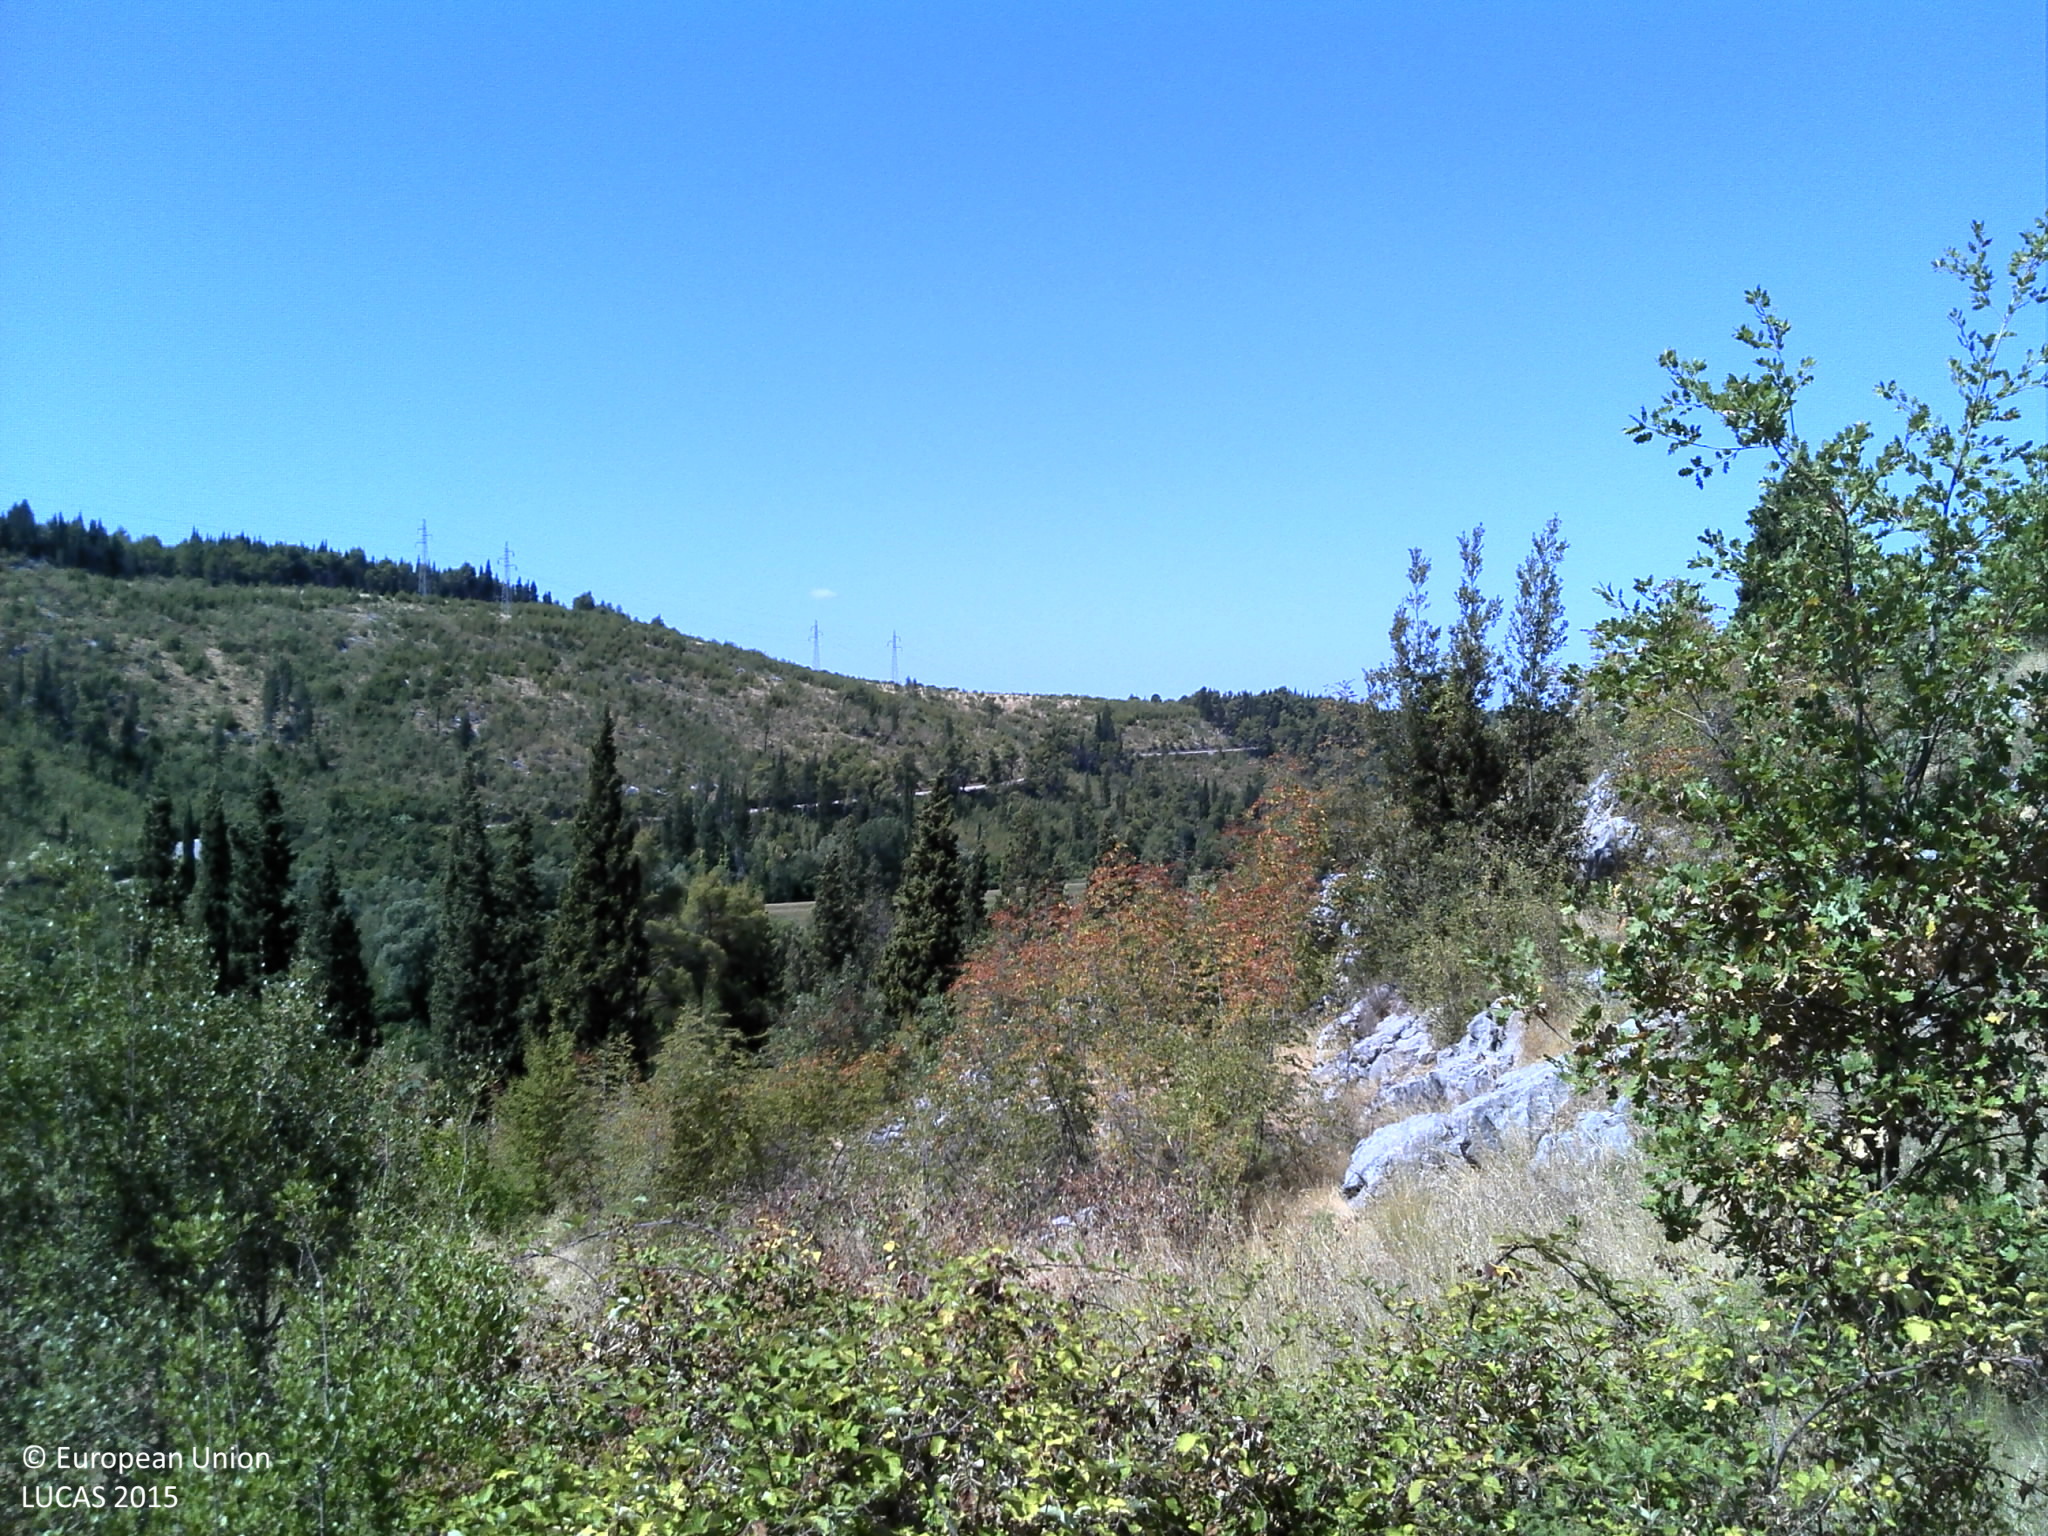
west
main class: Shrubland
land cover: Shrubland with sparse tree cover
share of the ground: > 75 %
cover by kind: shrubs 50 %, unconsolidated bare surface 30 %, herbaceous plants 15 %, coniferous forest trees 5 %
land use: Semi-natural and natural areas not in use
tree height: < 5 m
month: July
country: HR
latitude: 43.0343
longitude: 17.6620
